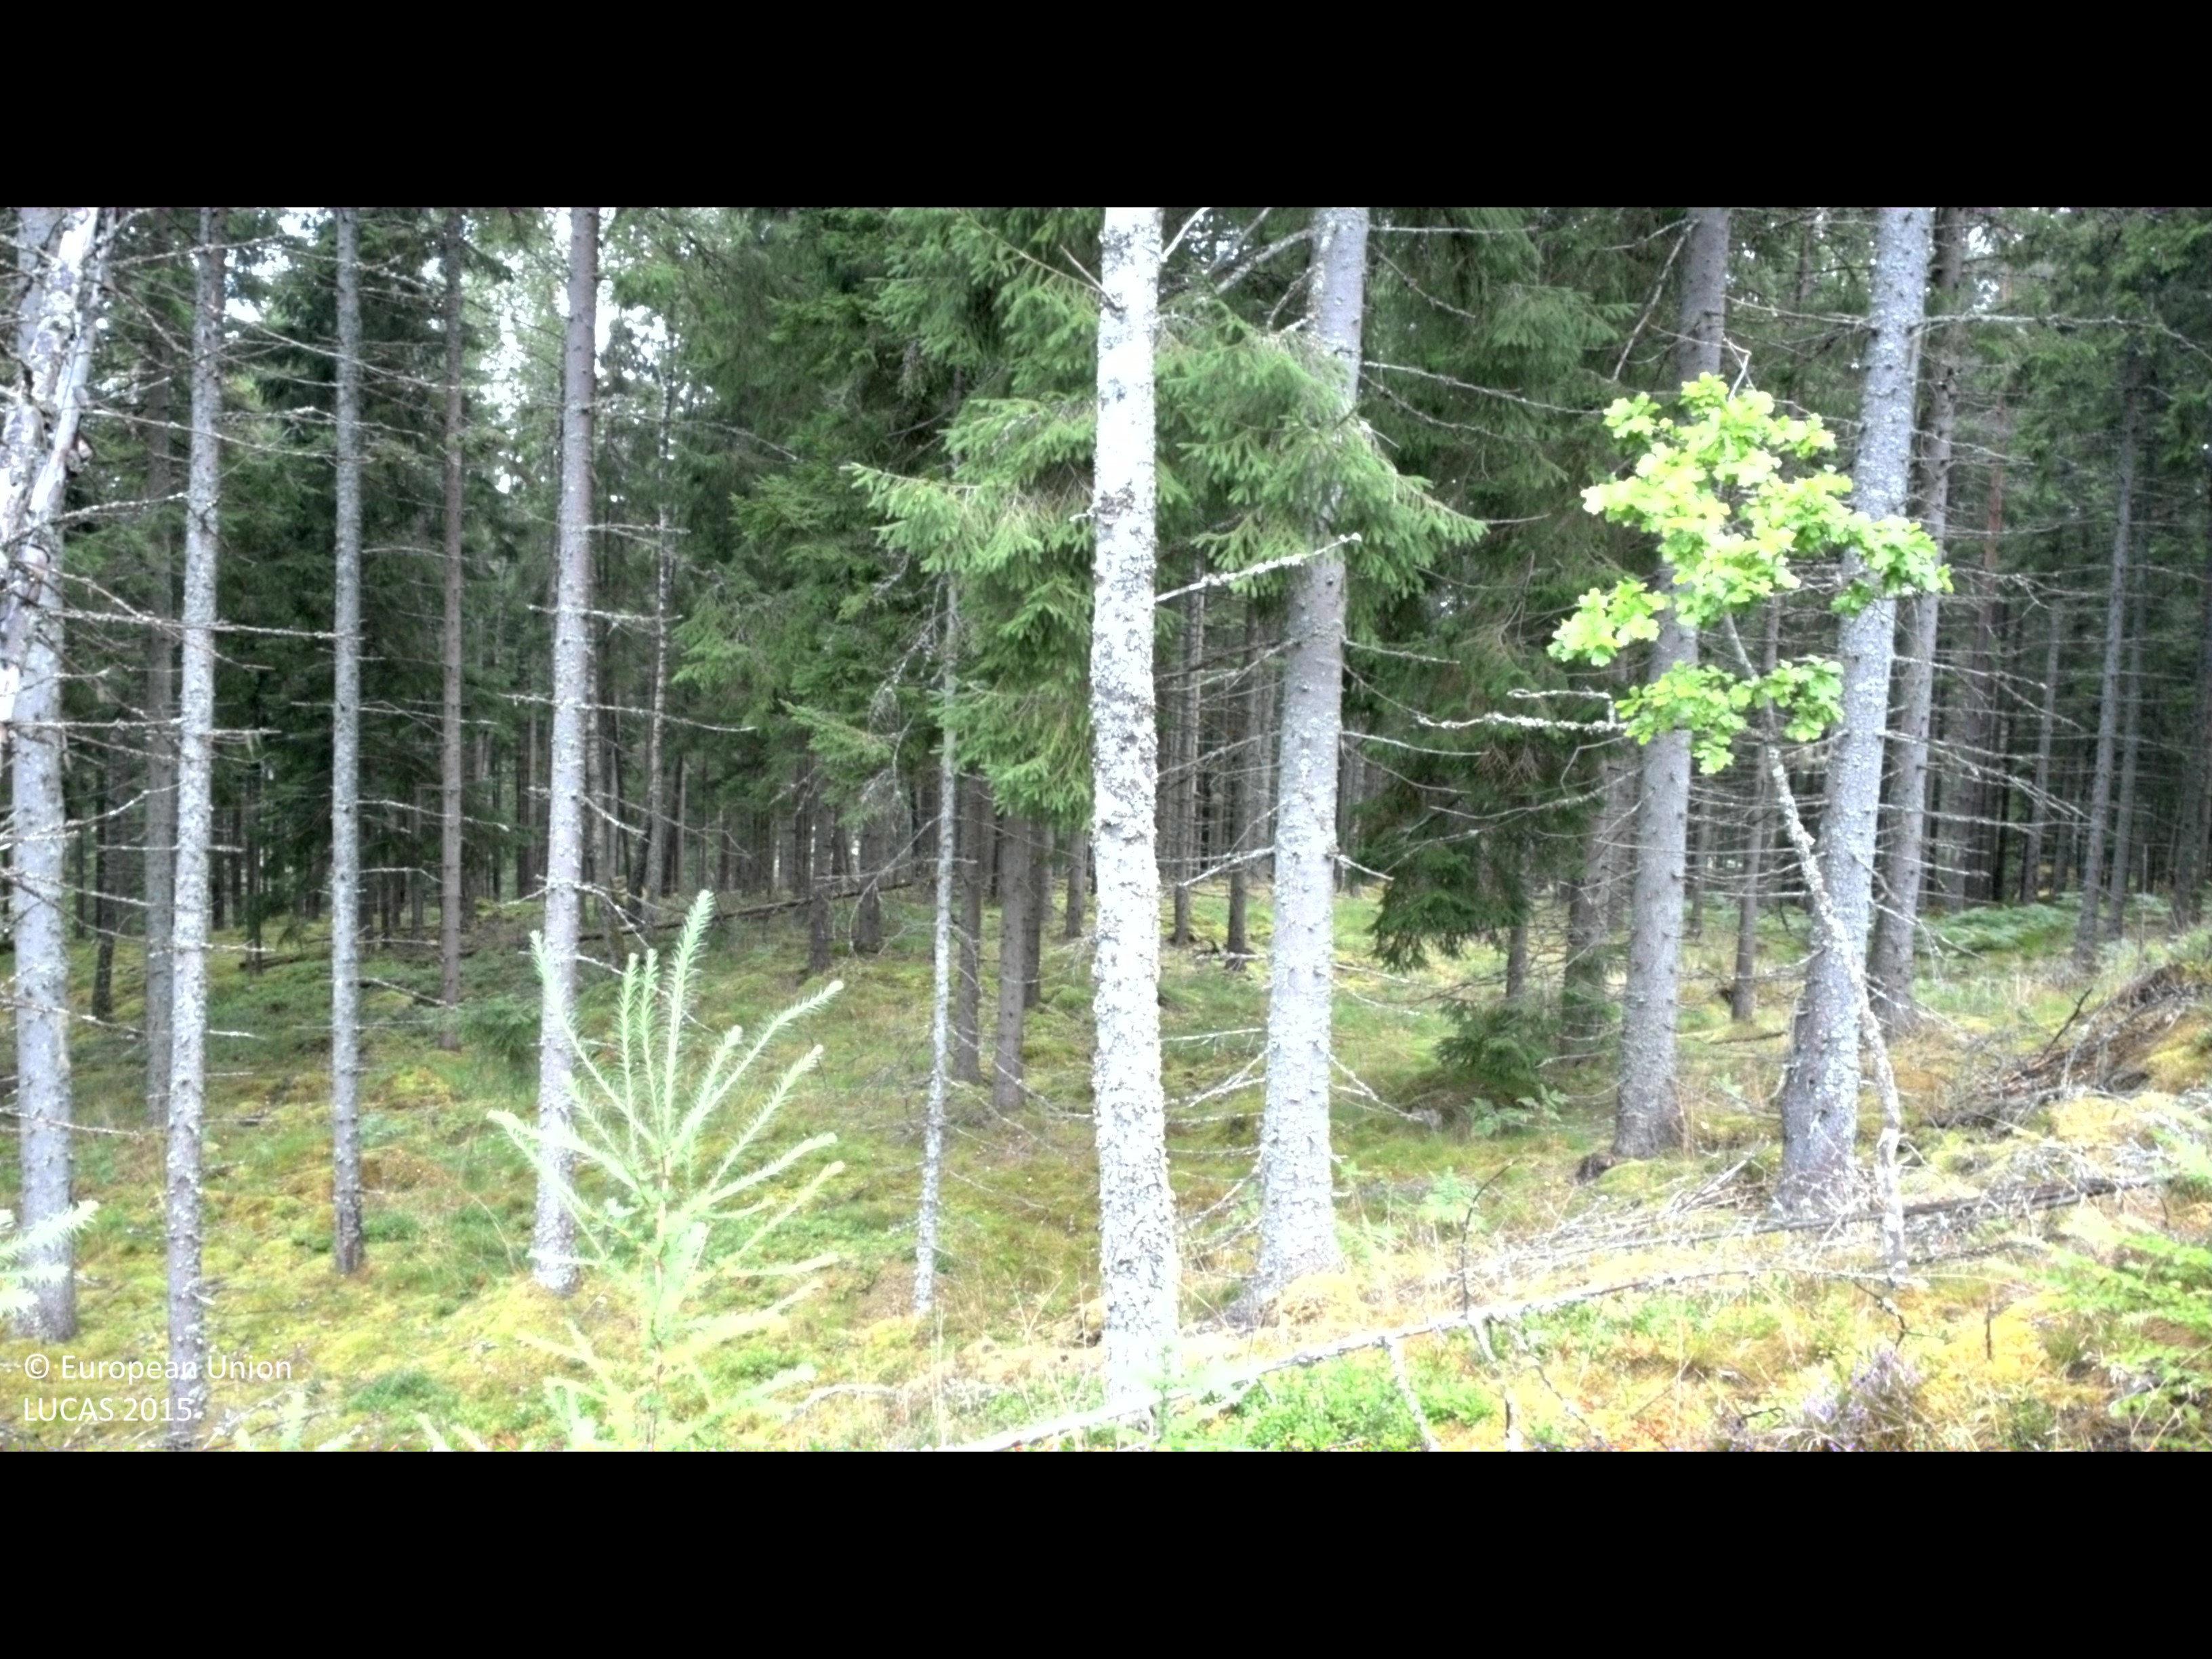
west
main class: Woodland
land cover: Other mixed woodland
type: boreal forest
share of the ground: 50 - 75 %
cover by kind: coniferous forest trees 35 %, broadleaved forest trees 35 %, shrubs 15 %, herbaceous plants 15 %
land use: Forestry
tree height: < 5 m
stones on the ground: 10 - 25 %
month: August
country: SE
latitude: 57.3366
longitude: 13.8334
